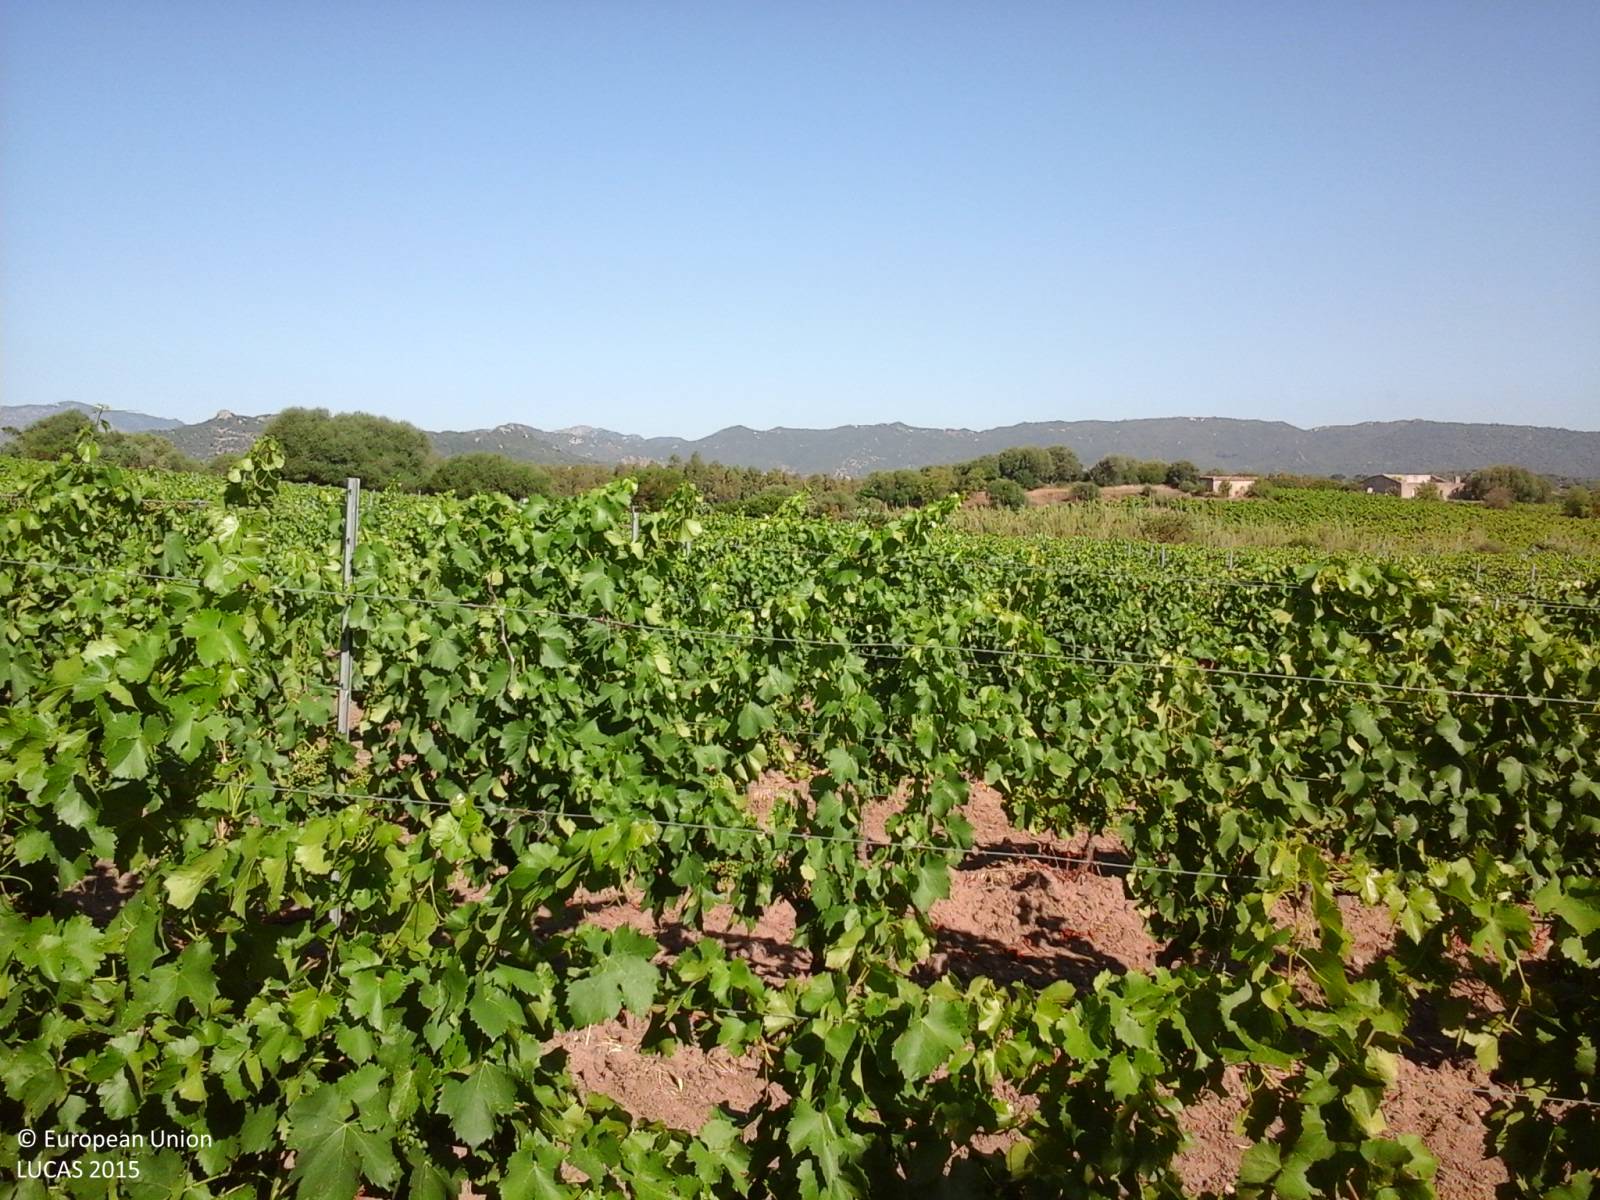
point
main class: Cropland
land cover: Vineyards
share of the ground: > 75 %
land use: Agriculture (excluding fallow land and kitchen gardens)
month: June
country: IT
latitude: 40.3205
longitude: 9.5200
